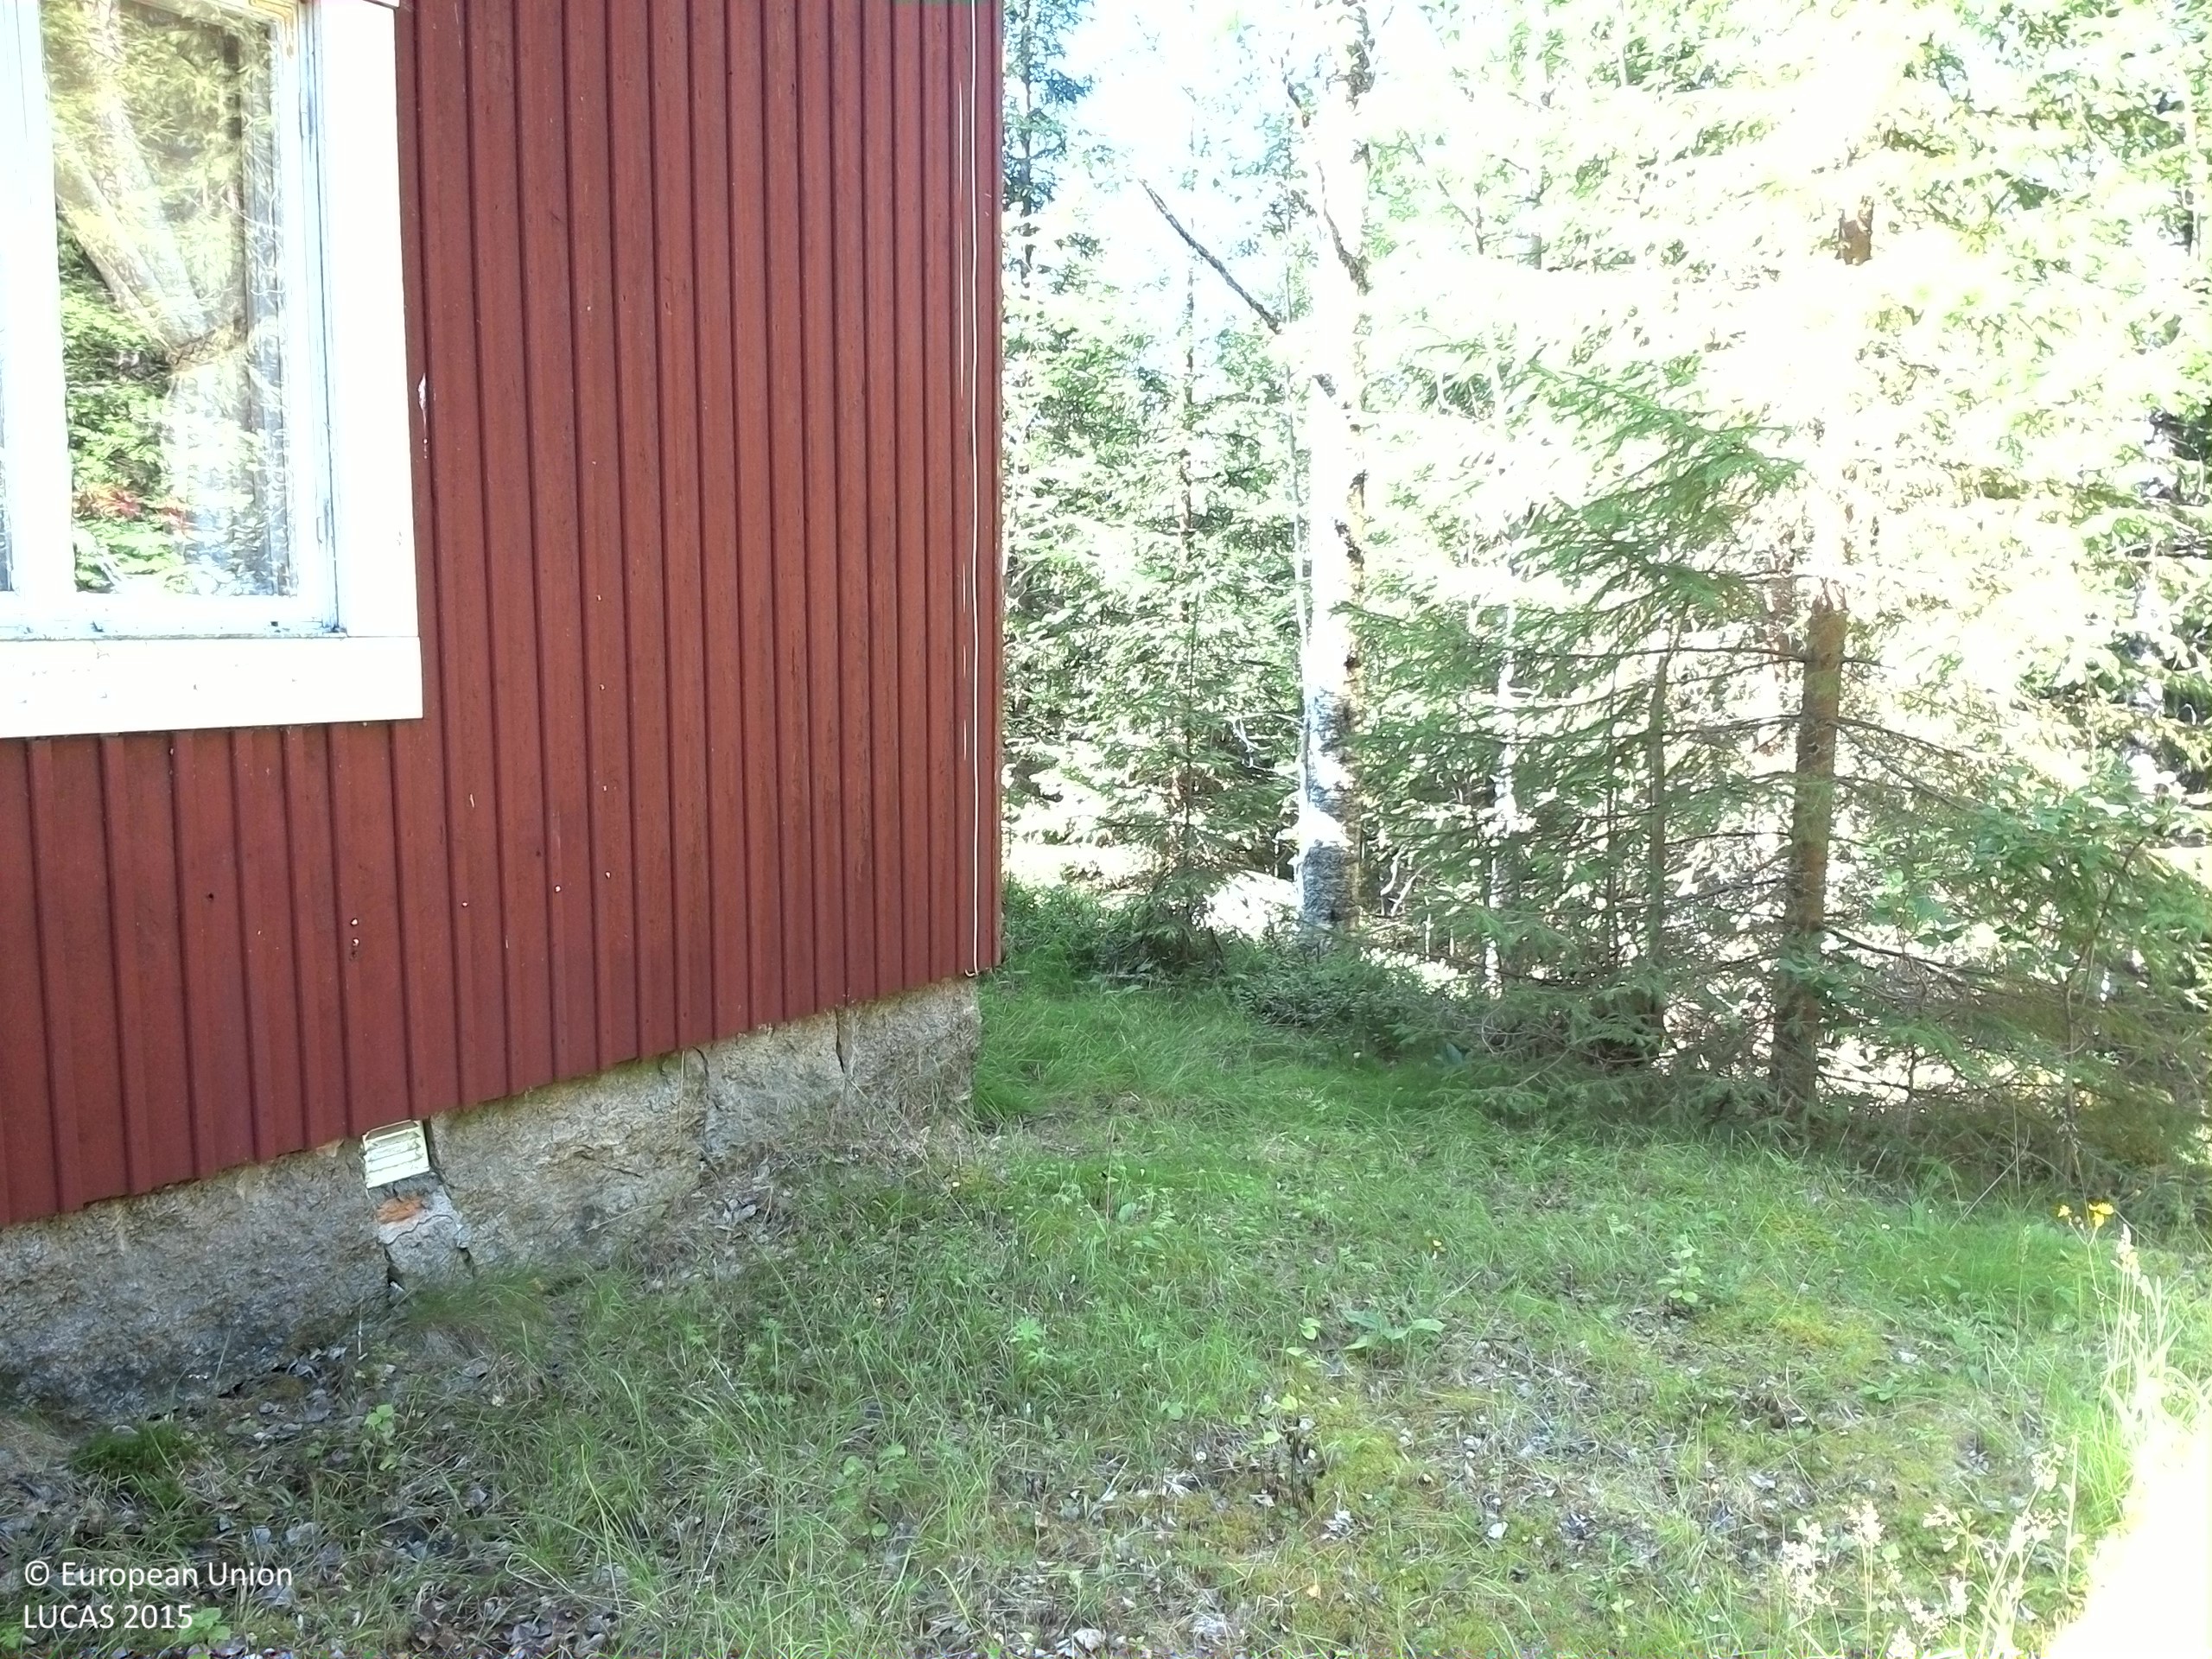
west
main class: Grassland
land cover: Grassland without tree/shrub cover
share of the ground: > 75 %
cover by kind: herbaceous plants 75 %, lichens and mosses 25 %
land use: Residential
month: August
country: SE
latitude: 63.7977
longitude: 16.4070
